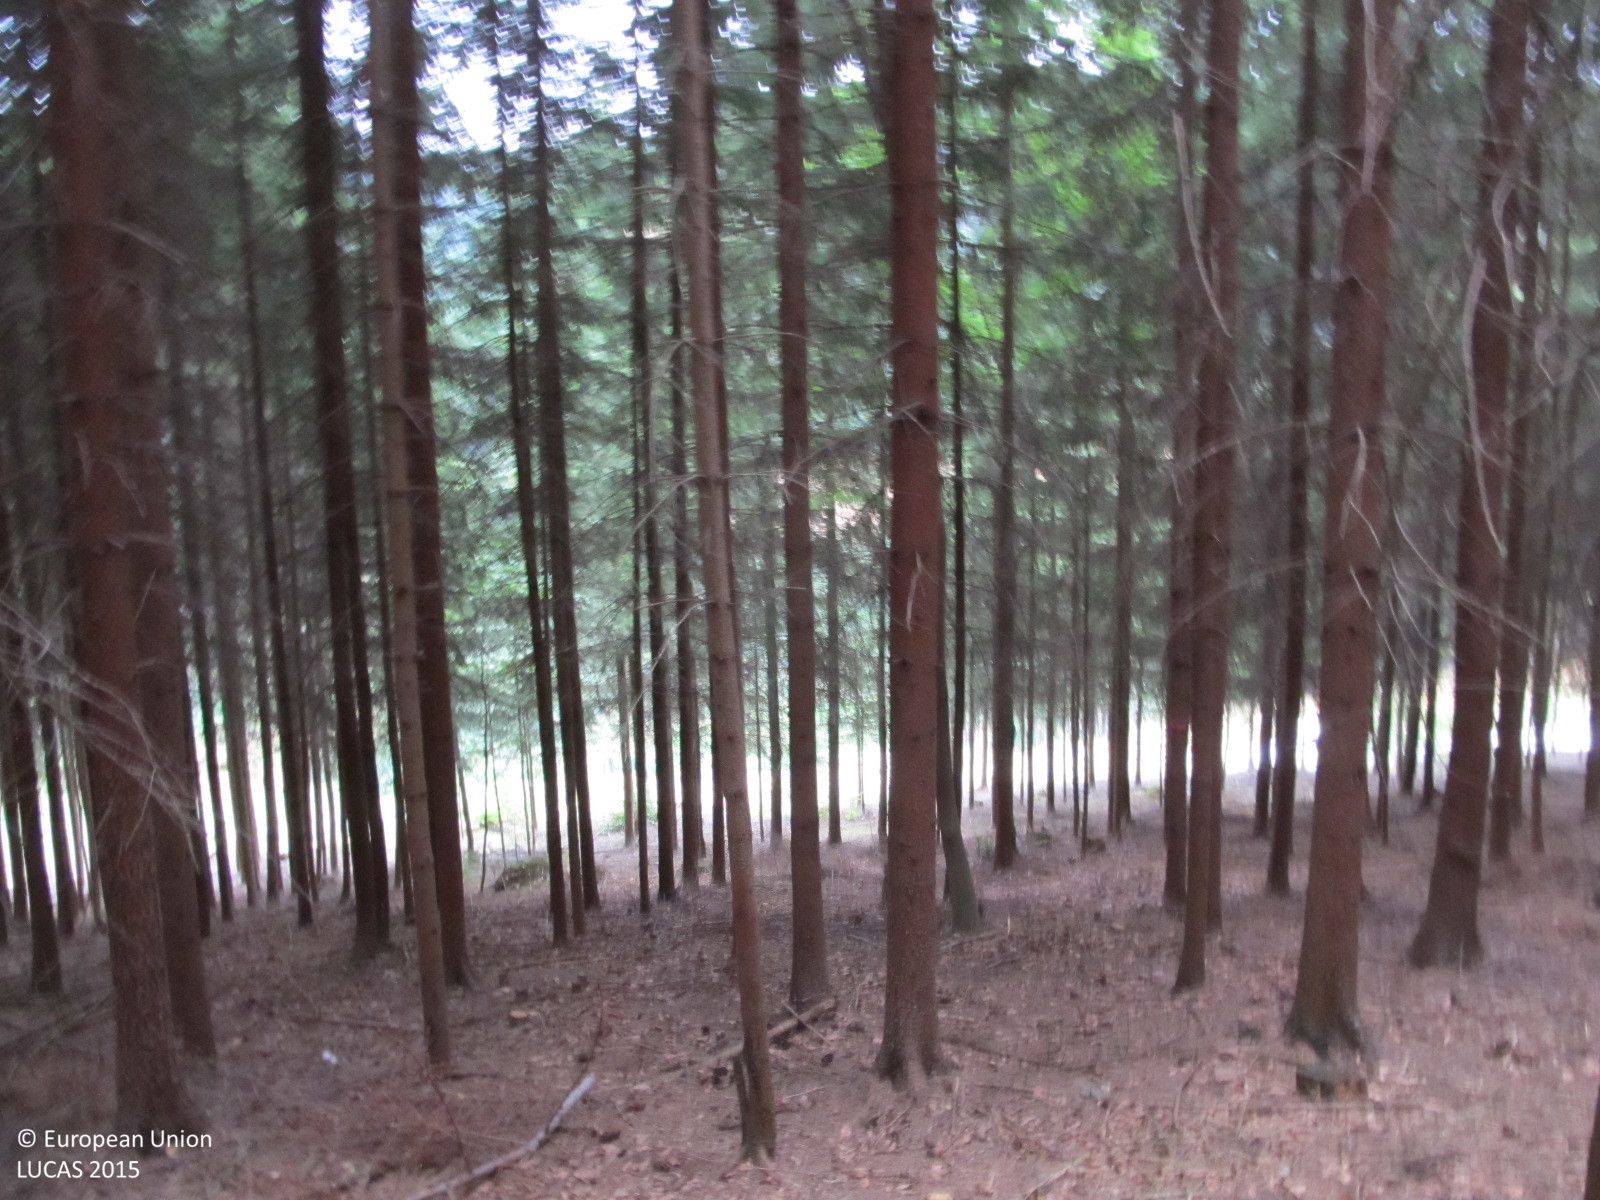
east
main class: Woodland
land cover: Spruce dominated coniferous woodland
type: hemiboreal forest and nemoral coniferous forest and mixed broadleaved-coniferous forest
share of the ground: > 75 %
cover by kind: coniferous forest trees 90 %, unconsolidated bare surface 10 %
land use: Forestry
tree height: > 5 m
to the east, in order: Spruce dominated coniferous woodland; Shruby margins; Tracks; Fences; Spruce dominated mixed woodland; Grassland without tree/shrub cover; Broadleaved woodland; Fences; Grassland without tree/shrub cover; Fences; Paved roads, cycling and walking lanes; Grassland without tree/shrub cover; Rivers and streams; Broadleaved woodland; Spontaneously vegetated surfaces; Tracks; Grassland with sparse tree/shrub cover
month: September
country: AT
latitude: 48.3304
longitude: 15.3031
